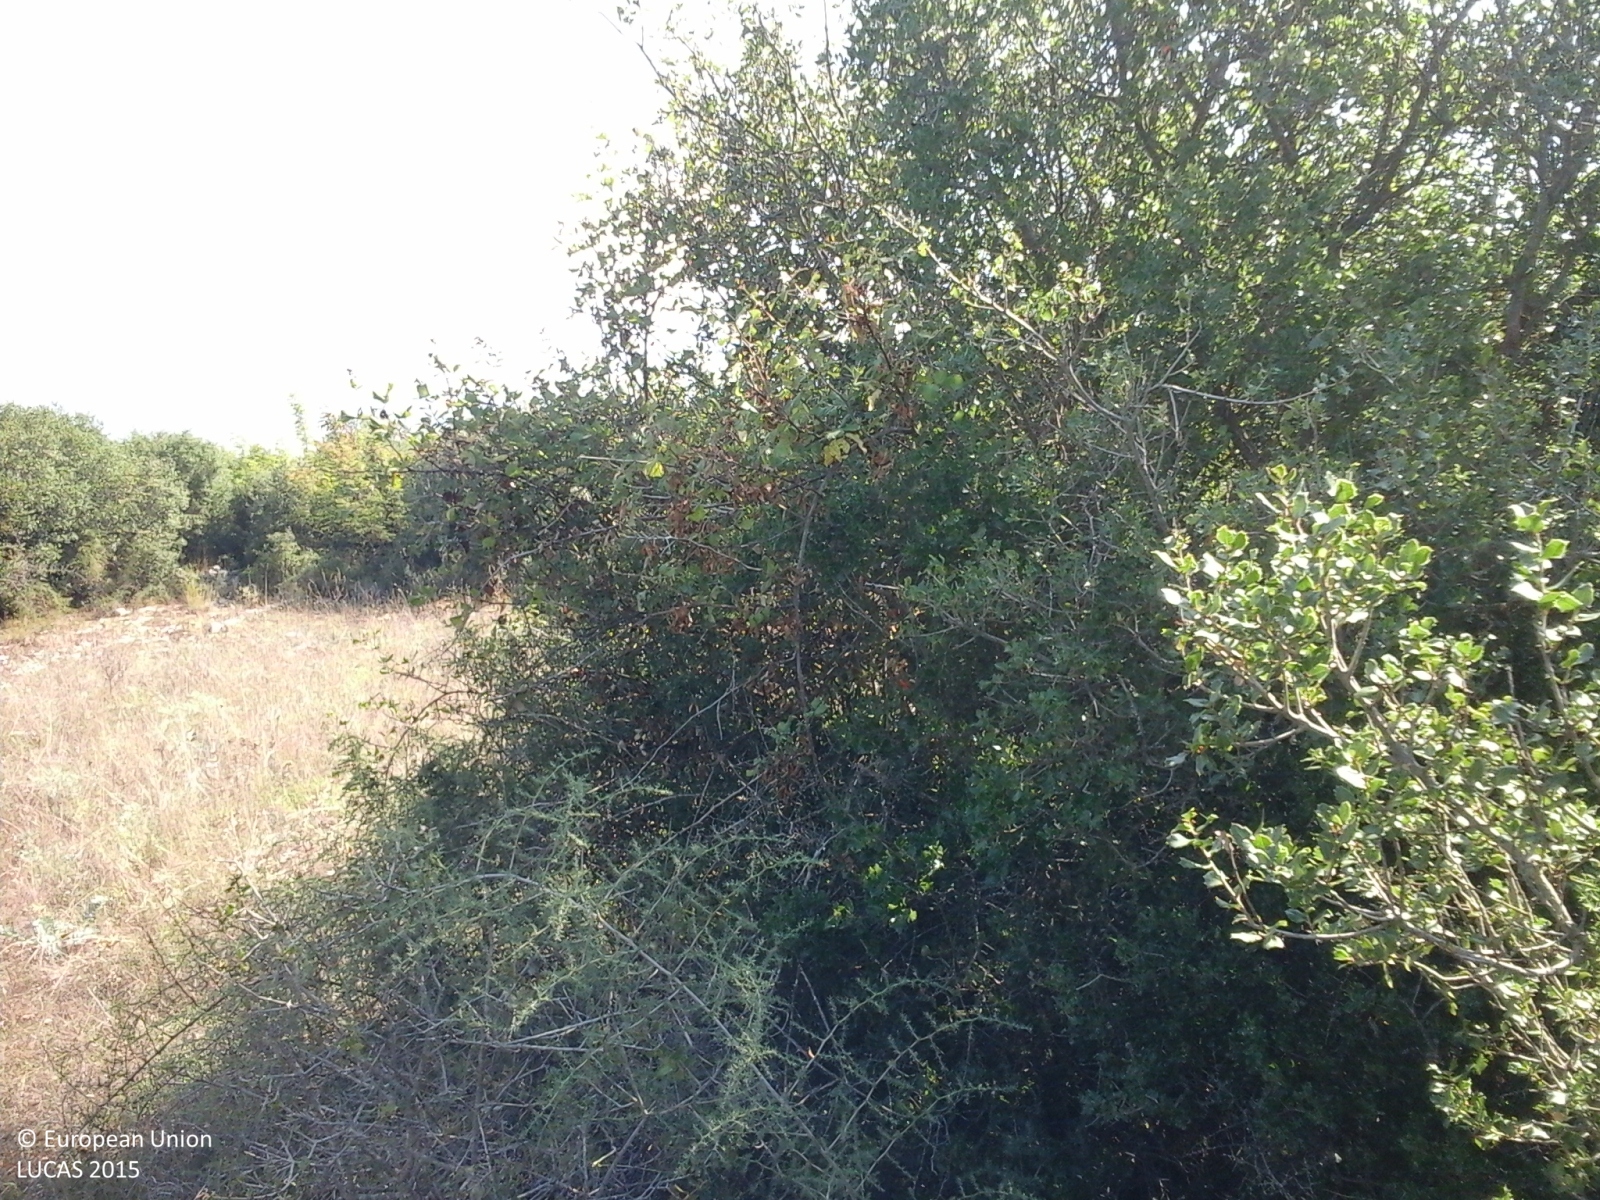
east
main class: Shrubland
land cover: Shrubland with sparse tree cover
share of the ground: 50 - 75 %
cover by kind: shrubs 65 %, herbaceous plants 20 %, unconsolidated bare surface 10 %, broadleaved forest trees 5 %
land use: Semi-natural and natural areas not in use
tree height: < 5 m
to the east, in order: Shrubland with sparse tree cover; Broadleaved woodland; Tracks; Broadleaved woodland
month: September
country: GR
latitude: 39.7734
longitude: 20.6844
